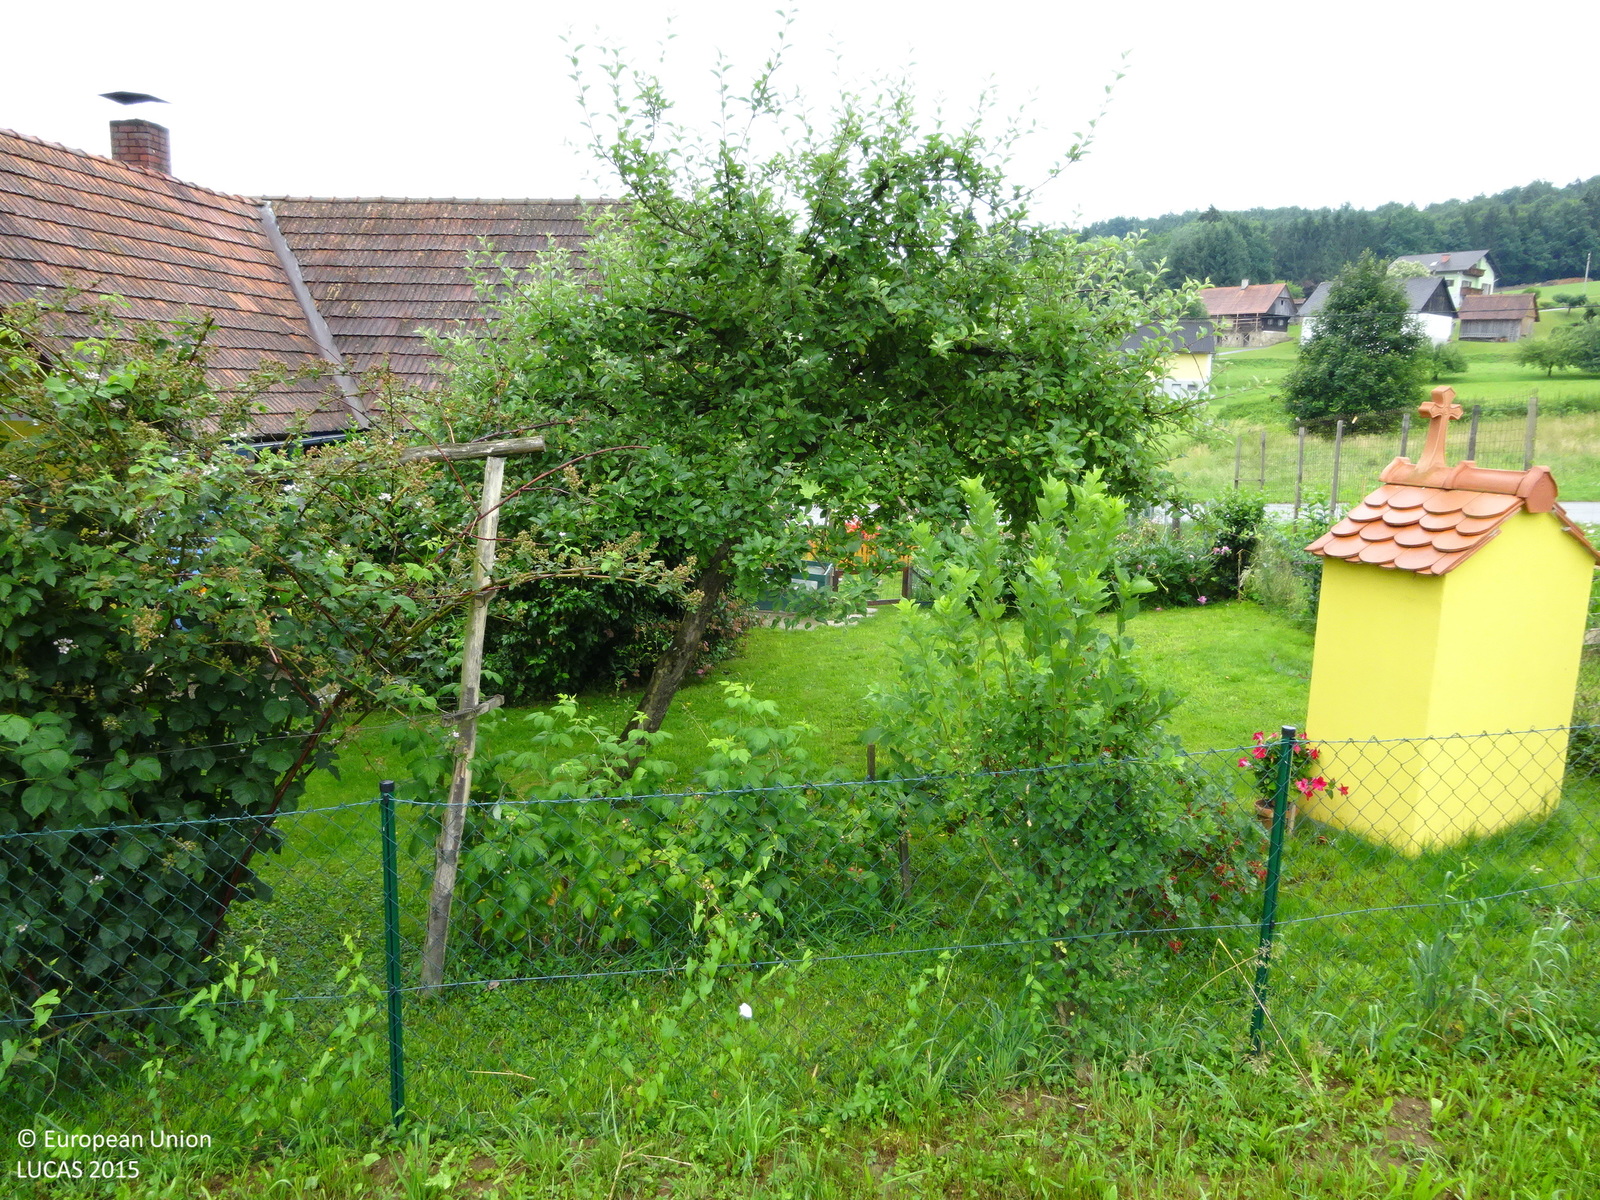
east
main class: Grassland
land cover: Grassland without tree/shrub cover
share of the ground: > 75 %
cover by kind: herbaceous plants 100 %
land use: Agriculture (excluding fallow land and kitchen gardens)
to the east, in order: Grassland without tree/shrub cover; Artificial constructions in urban areas; Grass margins; Ditches and canals; Grassland without tree/shrub cover; Electric lines; Grassland without tree/shrub cover; Apple fruit; Grassland without tree/shrub cover; Artificial constructions in urban areas; Grassland without tree/shrub cover
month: June
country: AT
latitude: 46.7560
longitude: 15.4060
